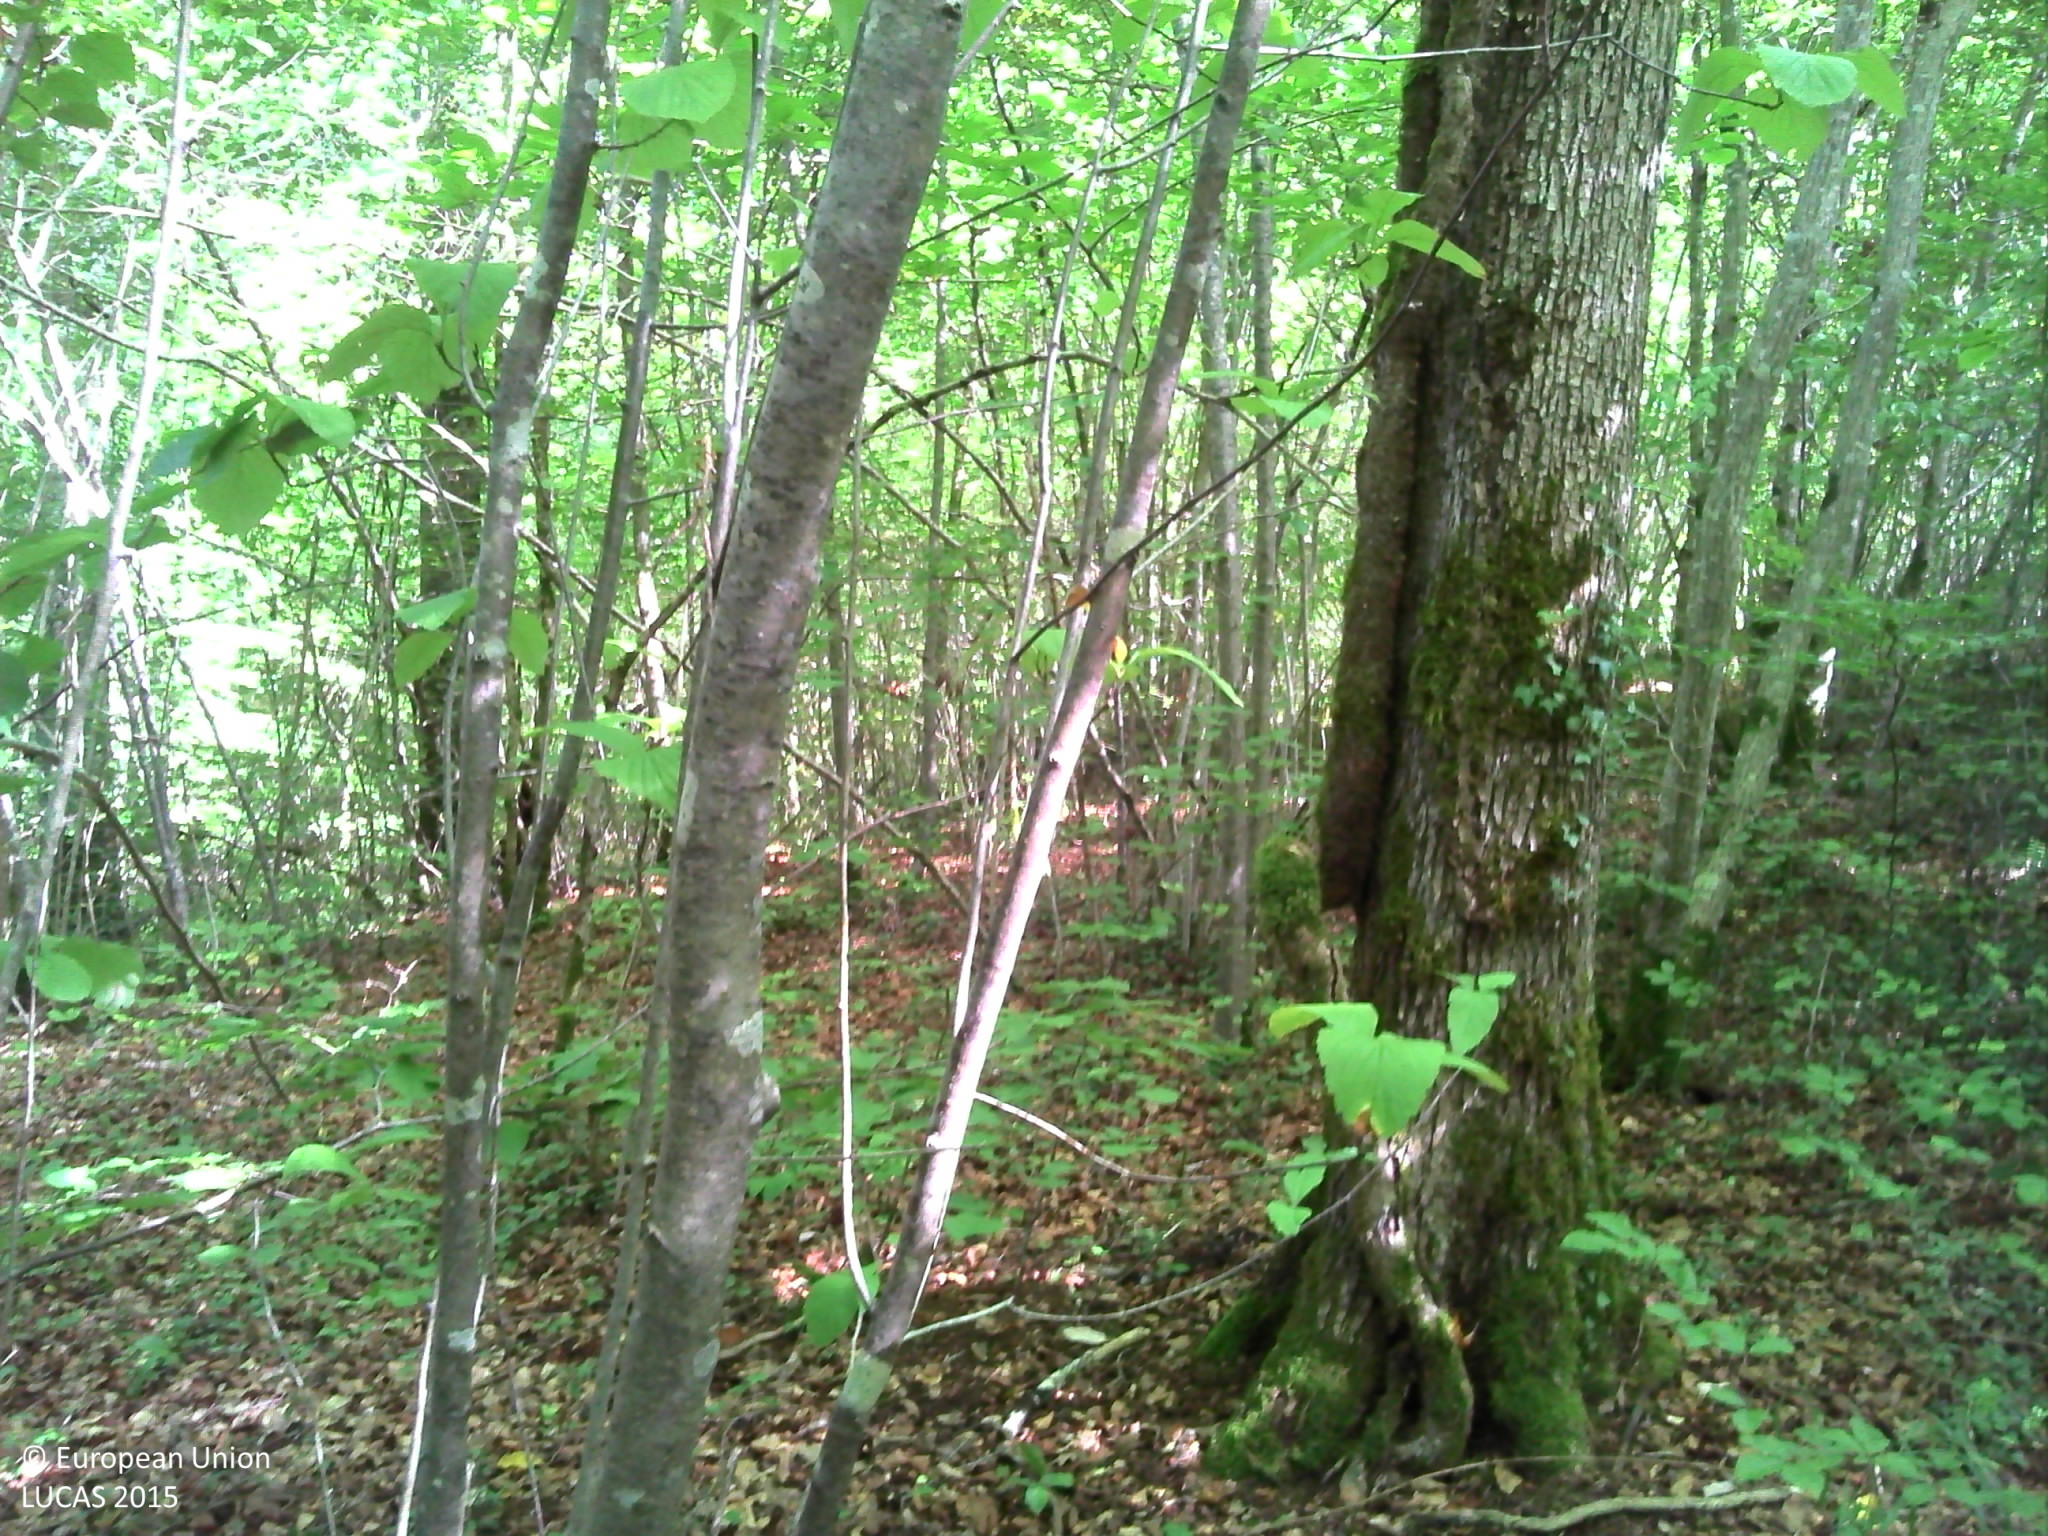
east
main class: Woodland
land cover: Broadleaved woodland
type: mesophytic deciduous forest
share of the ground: > 75 %
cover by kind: broadleaved forest trees 90 %, herbaceous plants 5 %, lichens and mosses 5 %
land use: Forestry
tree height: > 5 m
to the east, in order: Broadleaved woodland; Tracks; Broadleaved woodland; Tracks; Rock outcrops; Tracks
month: August
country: FR
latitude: 47.8343
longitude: 4.8824
